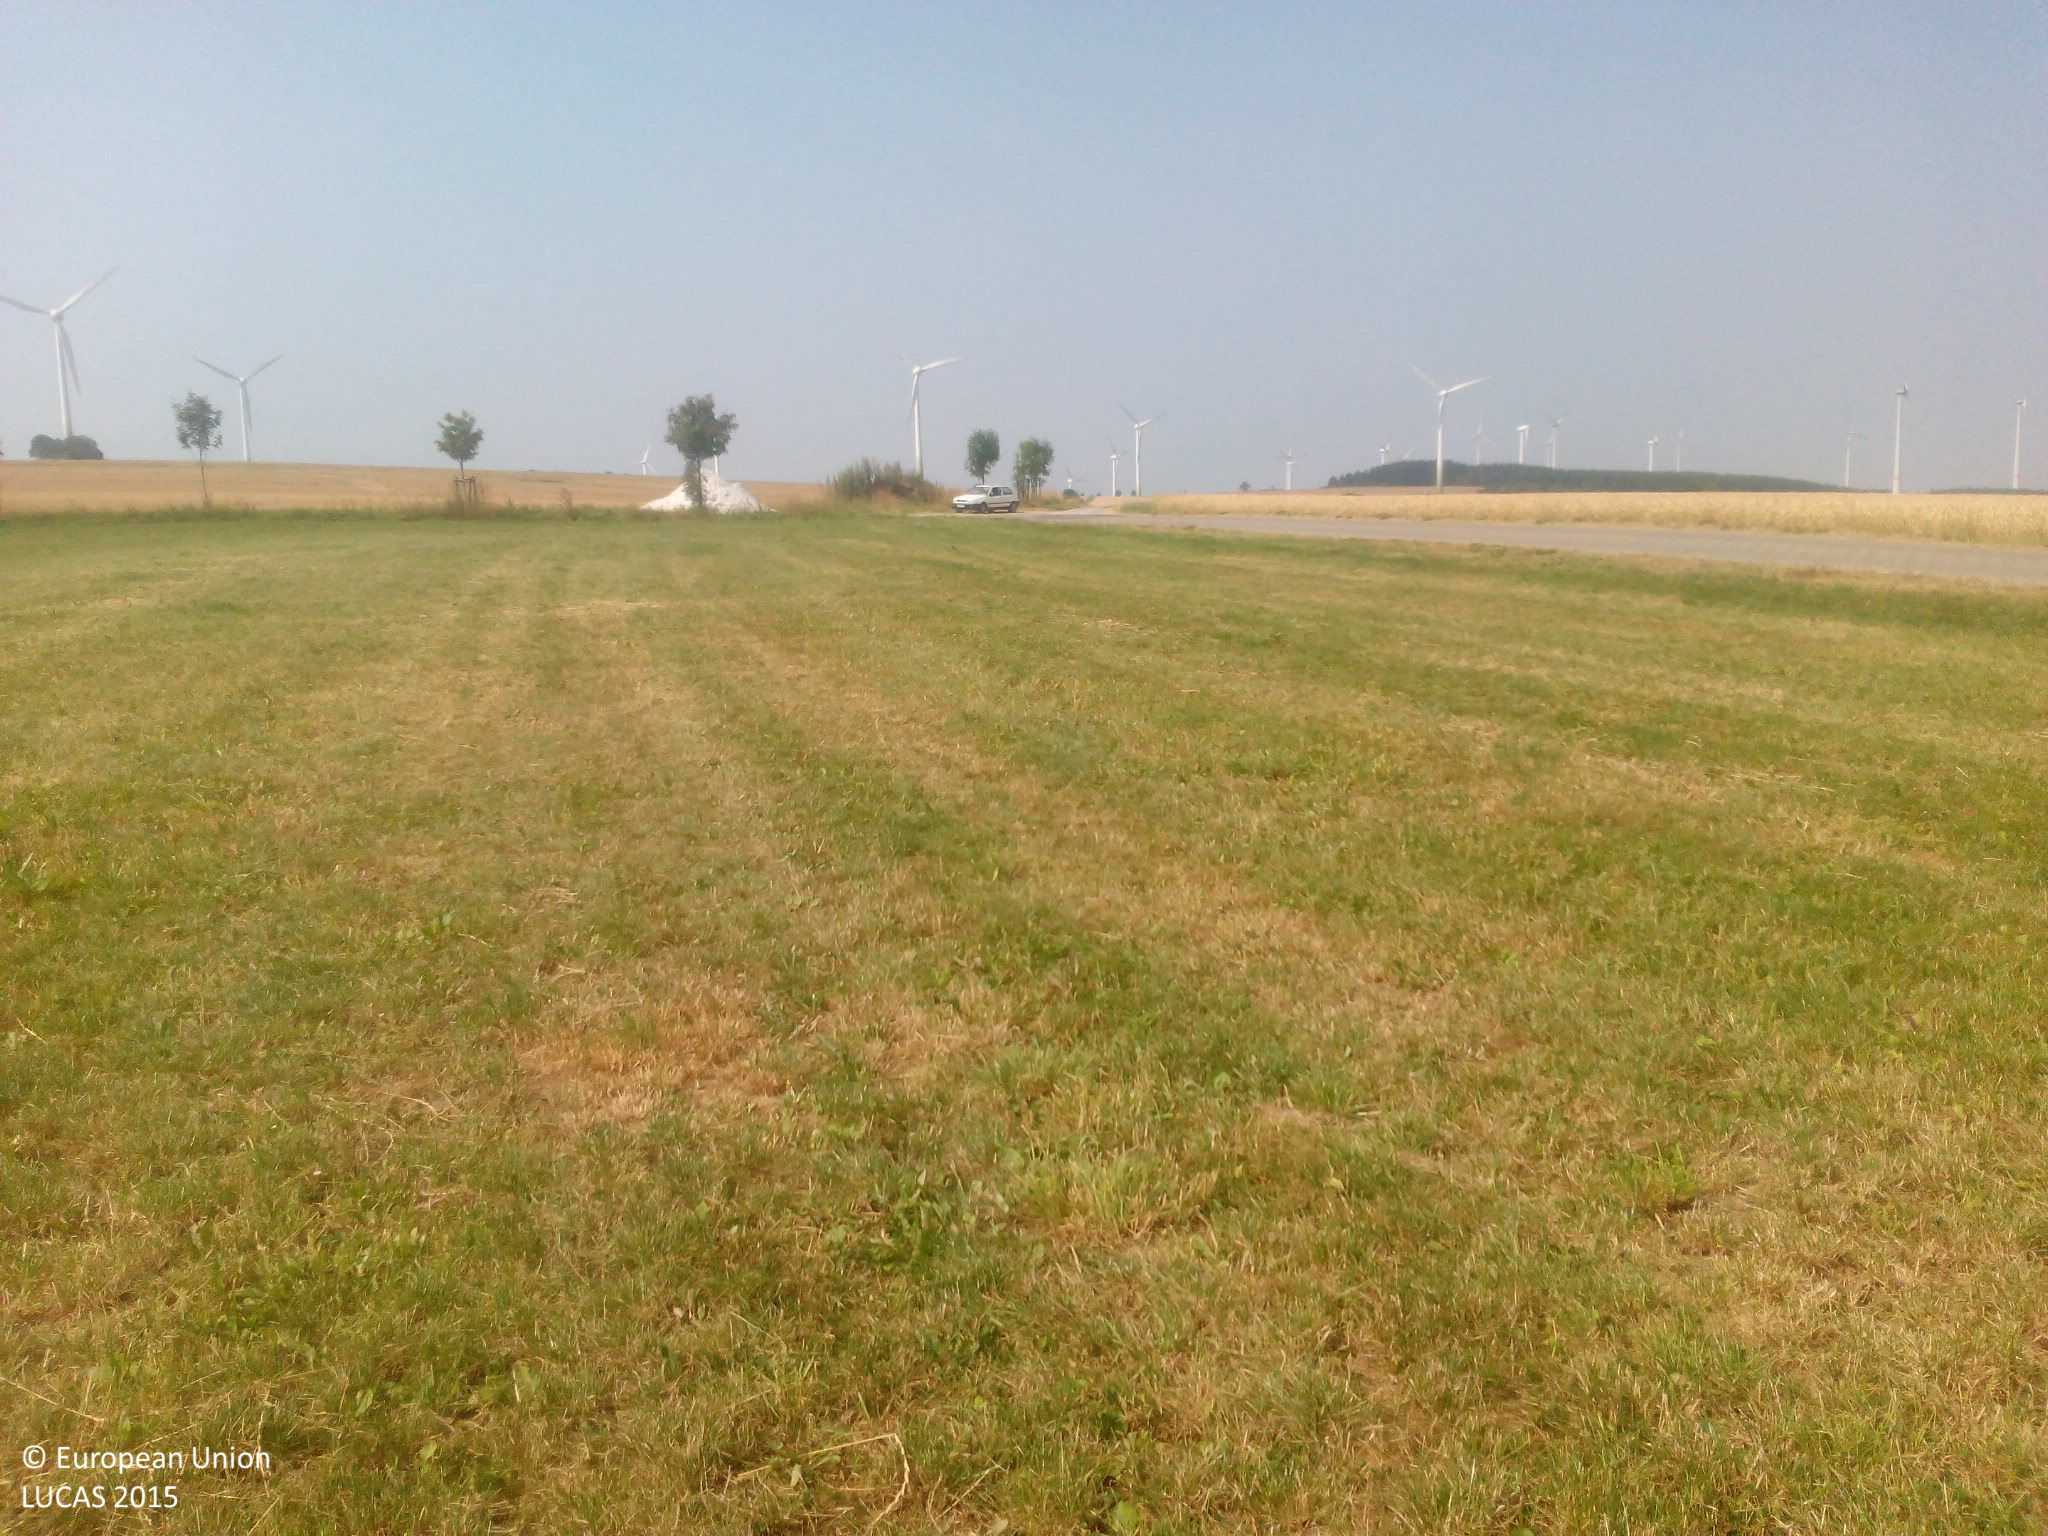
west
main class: Grassland
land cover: Grassland without tree/shrub cover
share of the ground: > 75 %
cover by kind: herbaceous plants 100 %
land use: Agriculture (excluding fallow land and kitchen gardens)
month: August
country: DE
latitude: 50.7458
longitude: 13.3875
